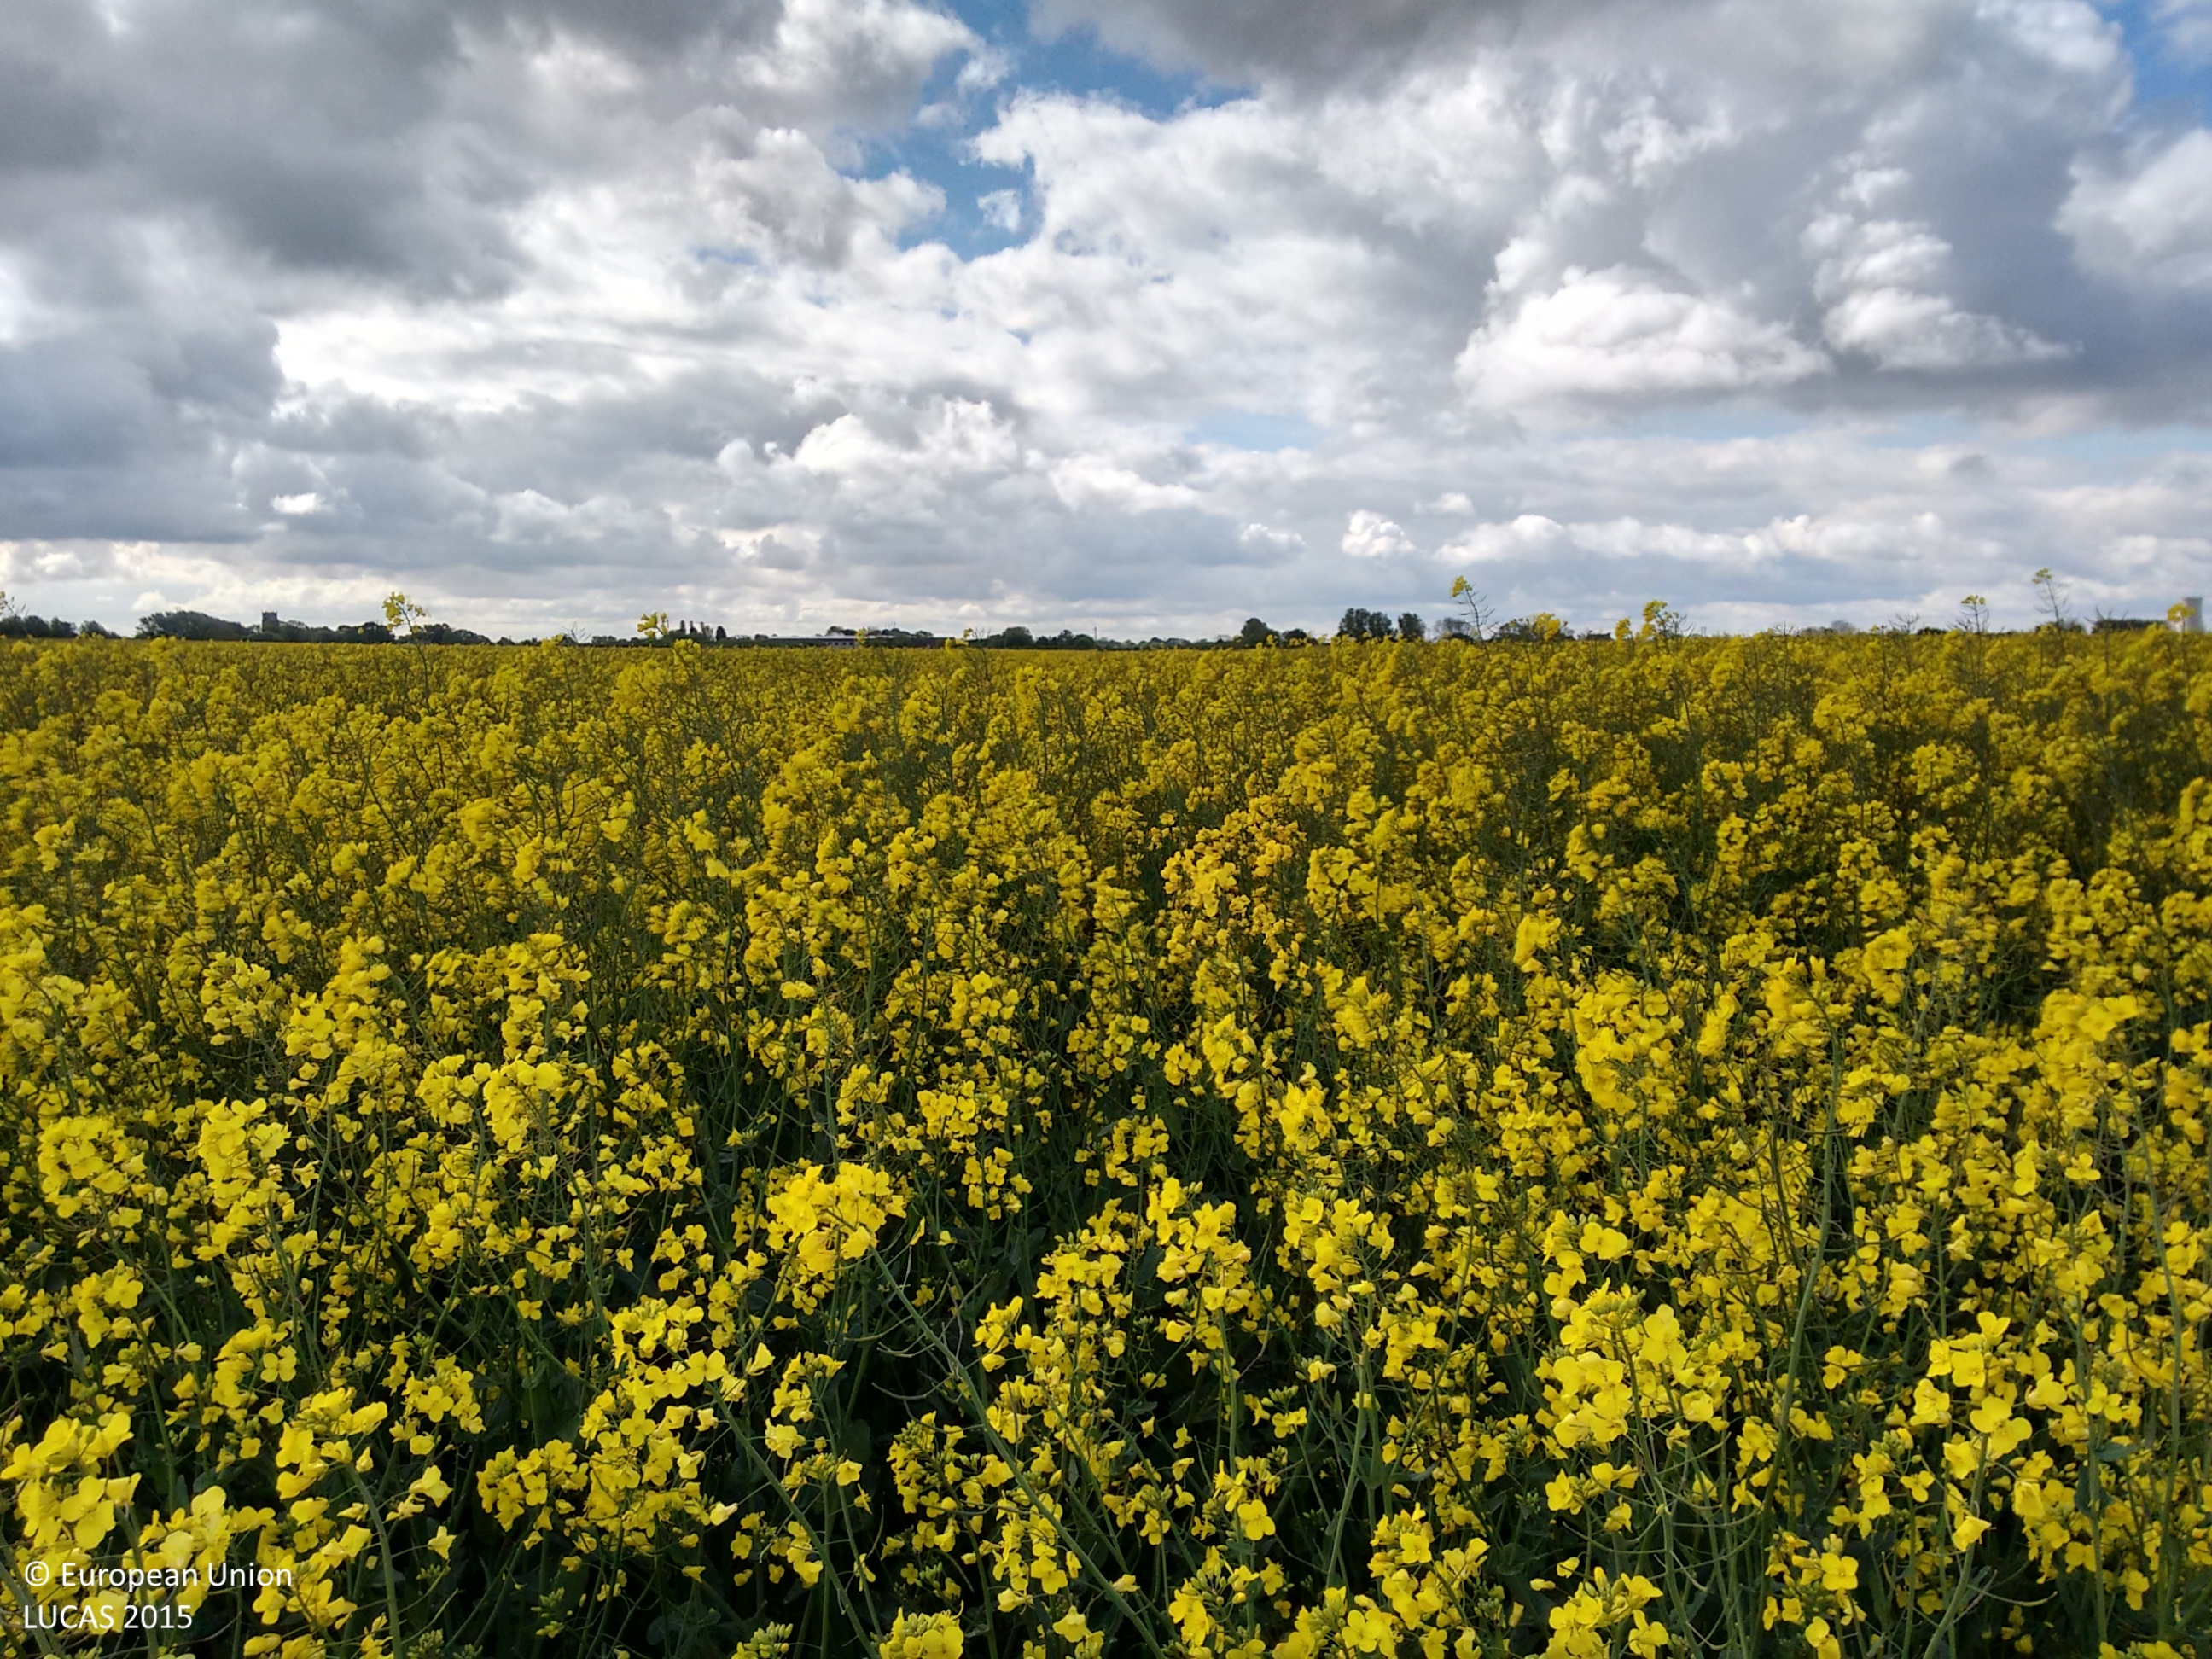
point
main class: Cropland
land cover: Rape and turnip rape
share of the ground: > 75 %
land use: Agriculture (excluding fallow land and kitchen gardens)
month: May
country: GB
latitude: 53.7666
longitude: -0.2133
